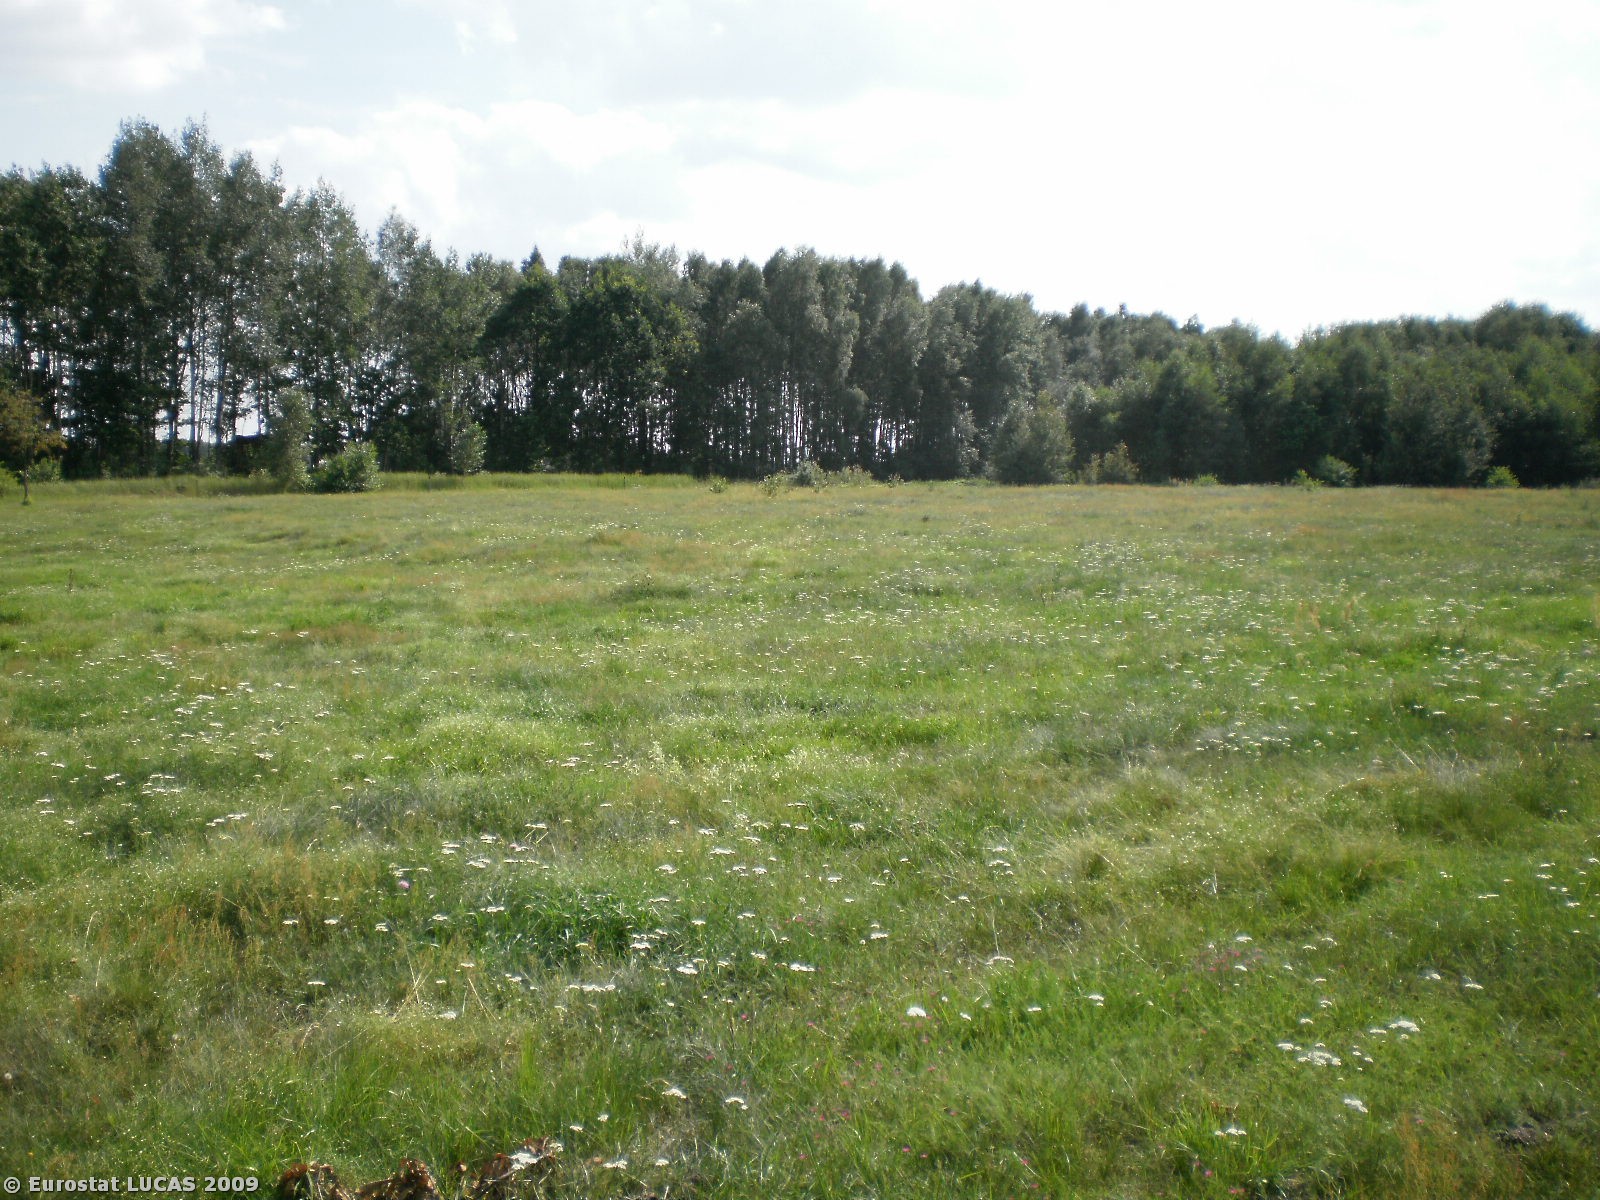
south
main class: Grassland
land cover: Grassland without tree/shrub cover
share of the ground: > 75 %
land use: Agriculture (excluding fallow land and kitchen gardens)
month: July
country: PL
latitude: 53.2824
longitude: 20.9774
